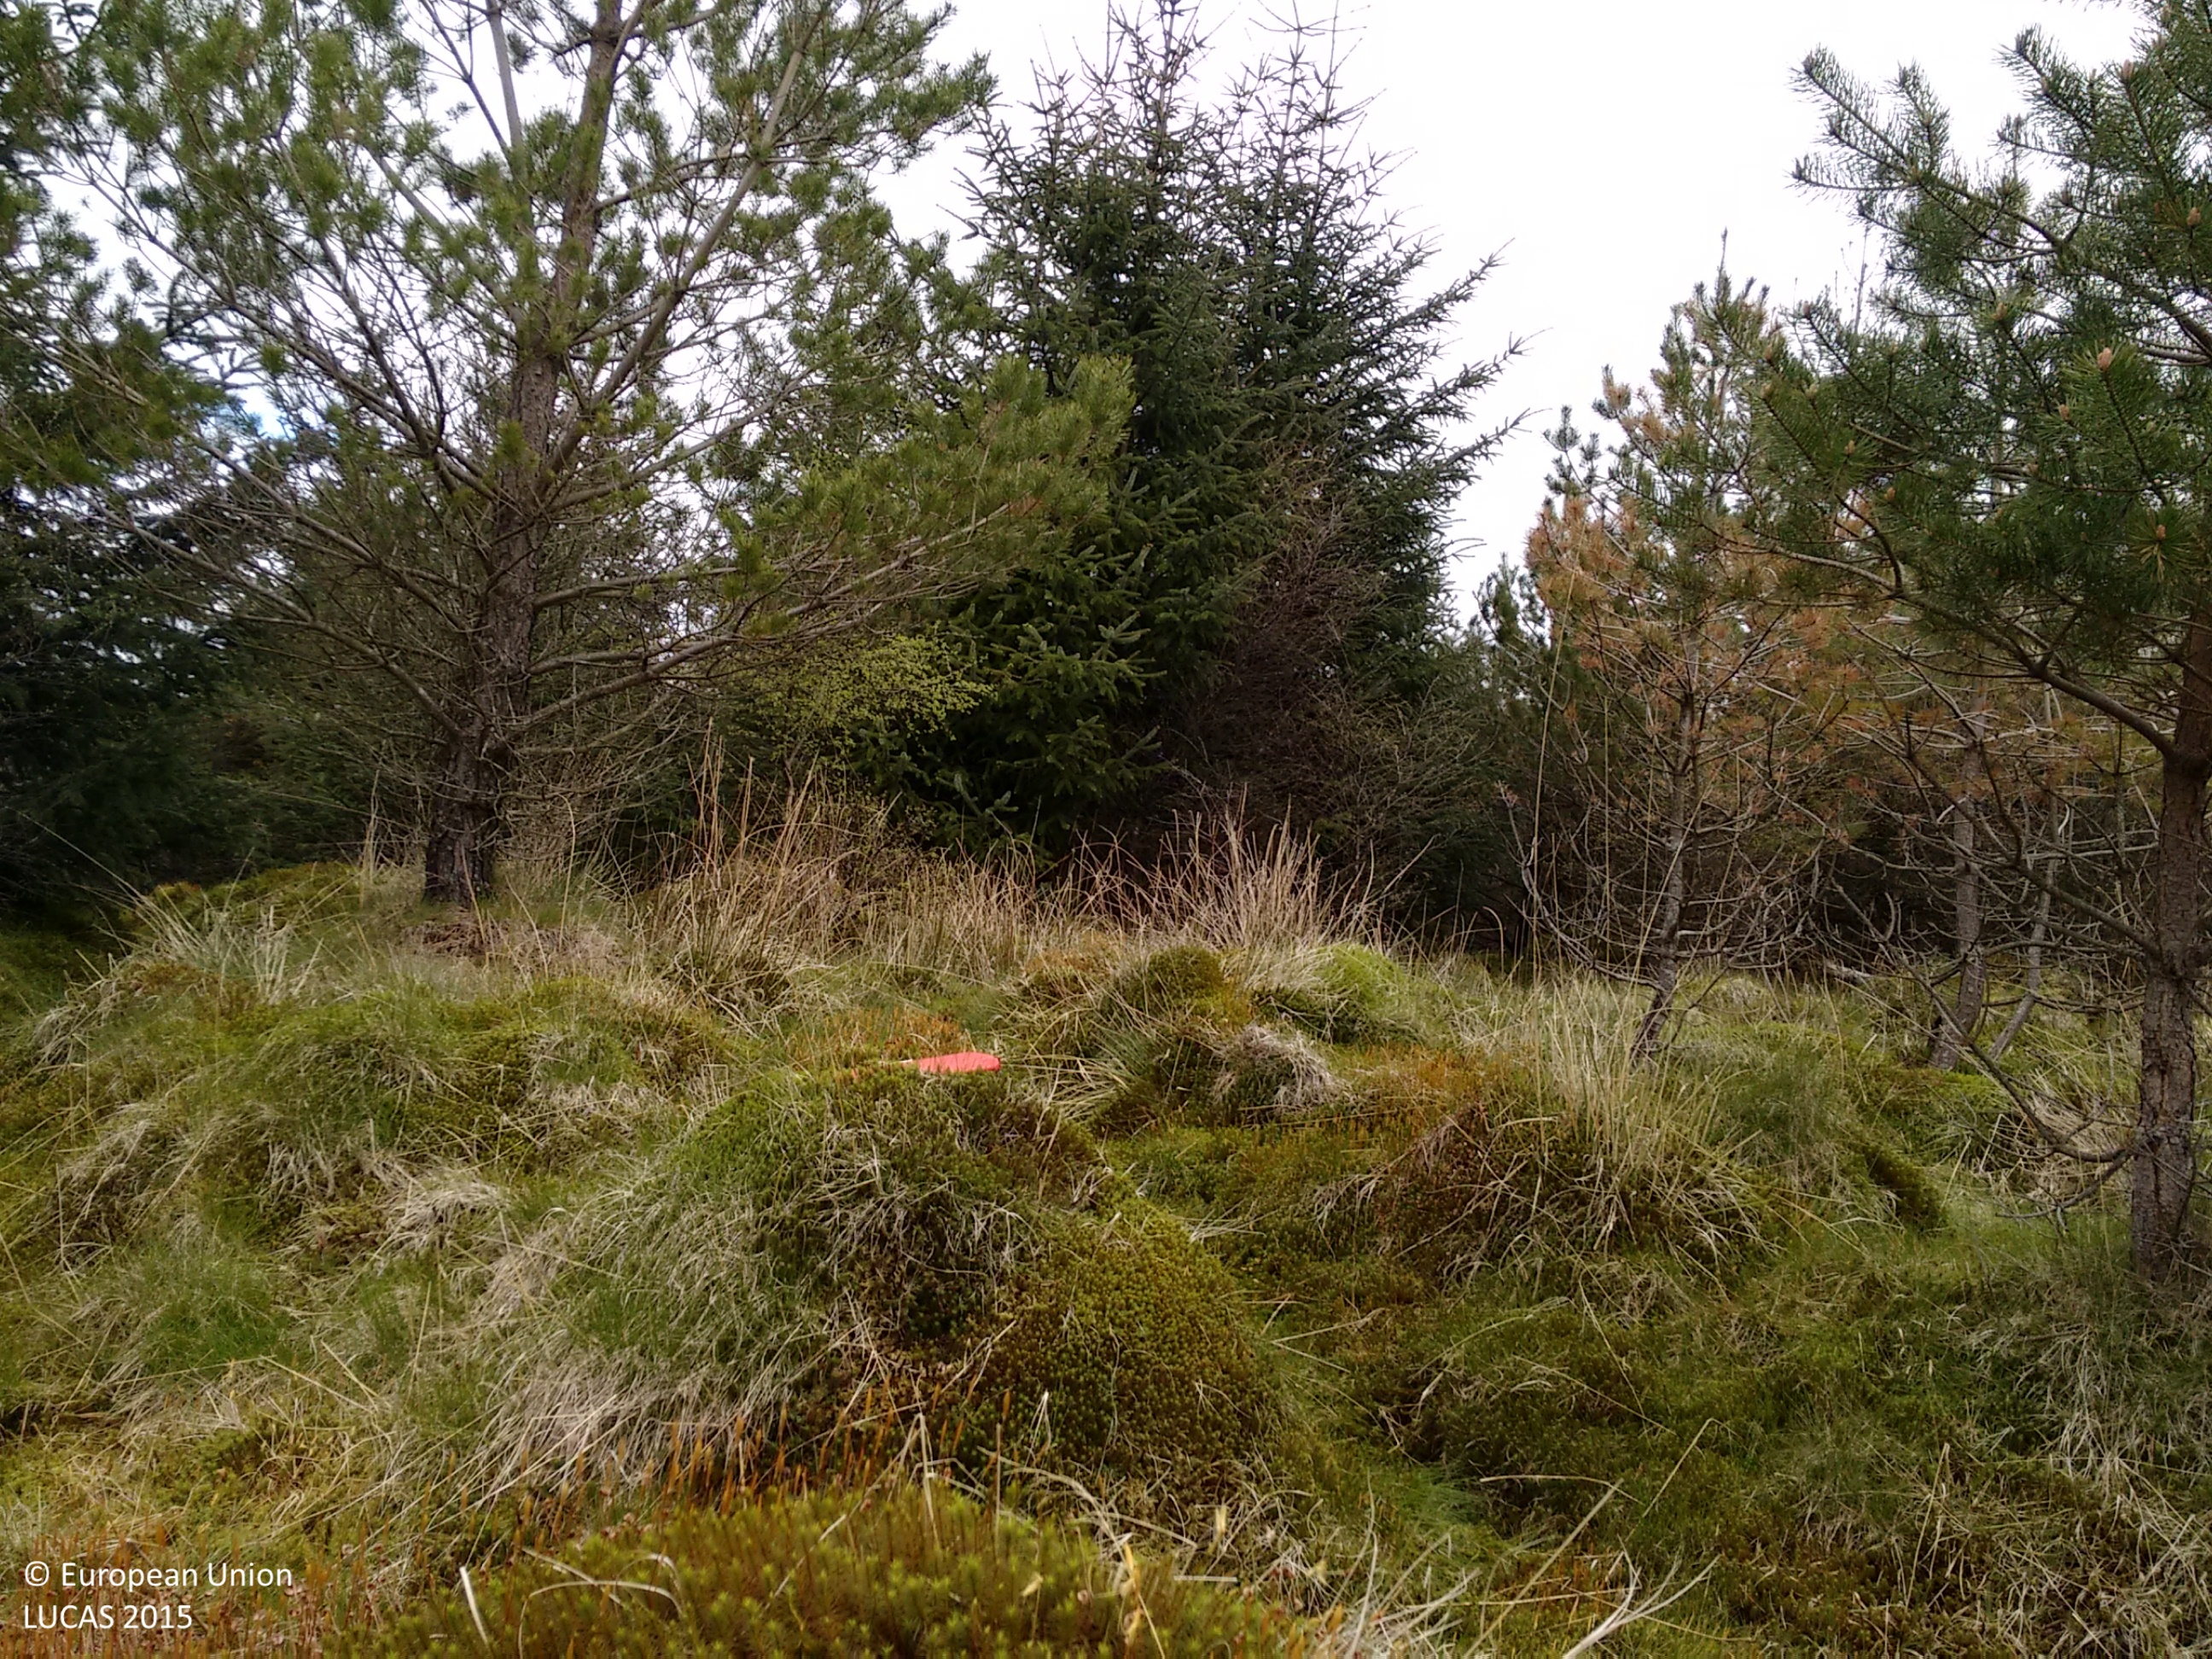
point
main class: Woodland
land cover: Pine dominated mixed woodland
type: exotic forest
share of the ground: > 75 %
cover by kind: coniferous forest trees 50 %, lichens and mosses 25 %, broadleaved forest trees 20 %, herbaceous plants 5 %
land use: Forestry
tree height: > 5 m
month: May
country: GB
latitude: 56.0153
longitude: -4.0275
